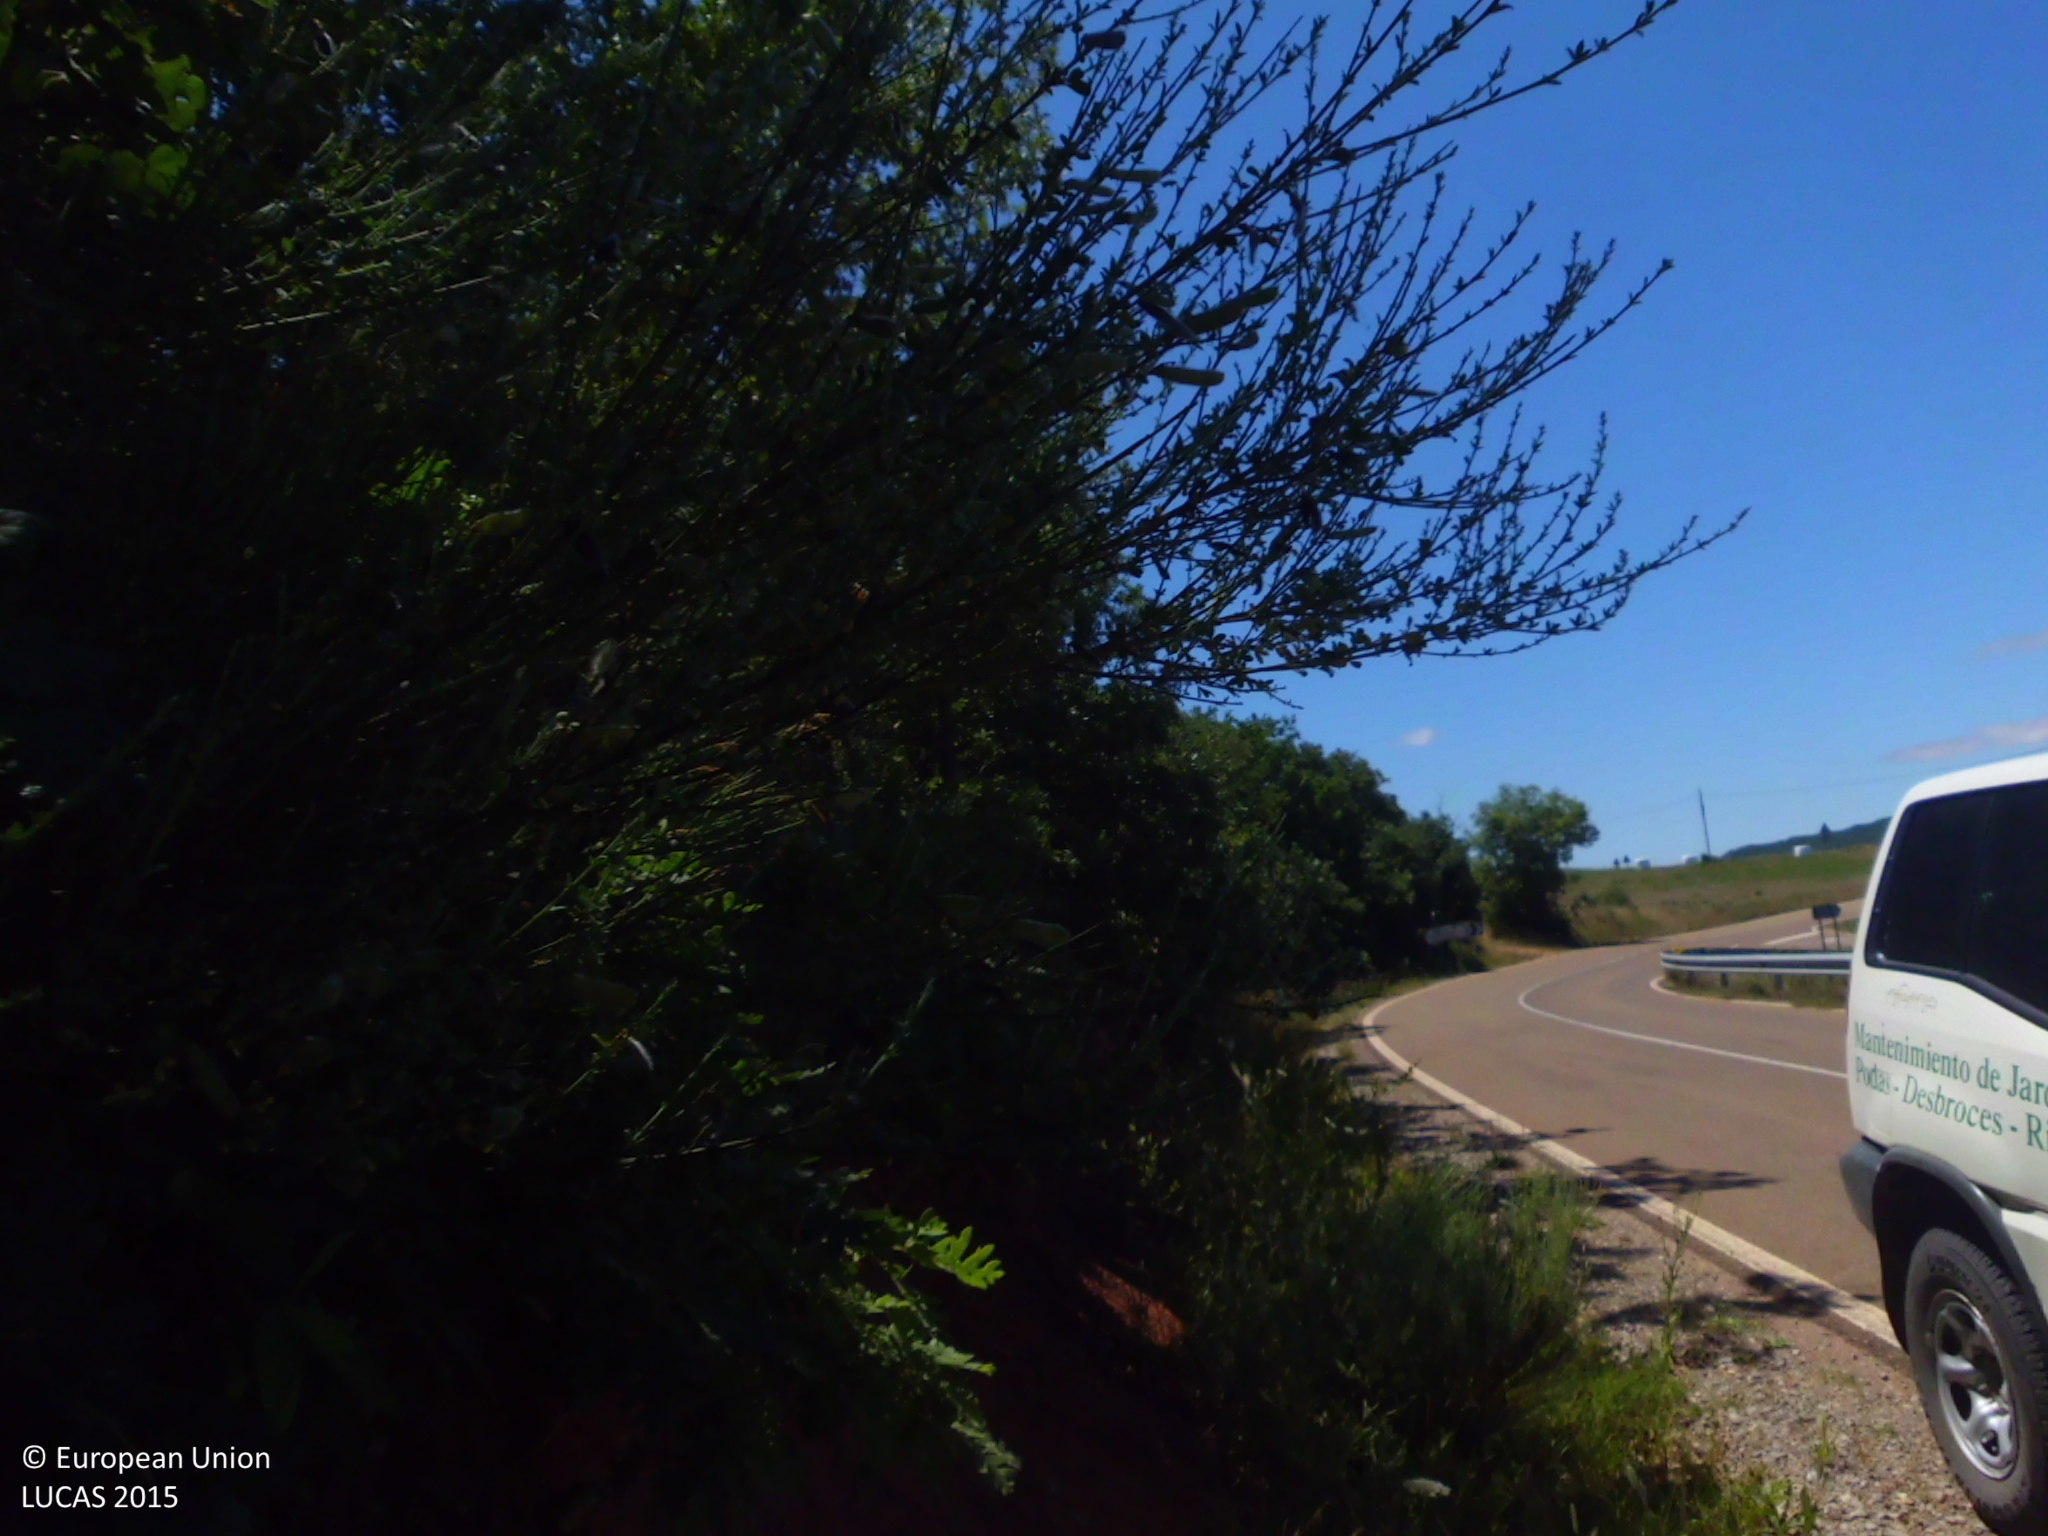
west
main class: Woodland
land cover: Broadleaved woodland
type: mesophytic deciduous forest
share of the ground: 50 - 75 %
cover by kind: broadleaved forest trees 50 %, herbaceous plants 20 %, consolidated bare surface 20 %, shrubs 10 %
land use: Semi-natural and natural areas not in use
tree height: > 5 m
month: July
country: ES
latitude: 42.7974
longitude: -4.0957
